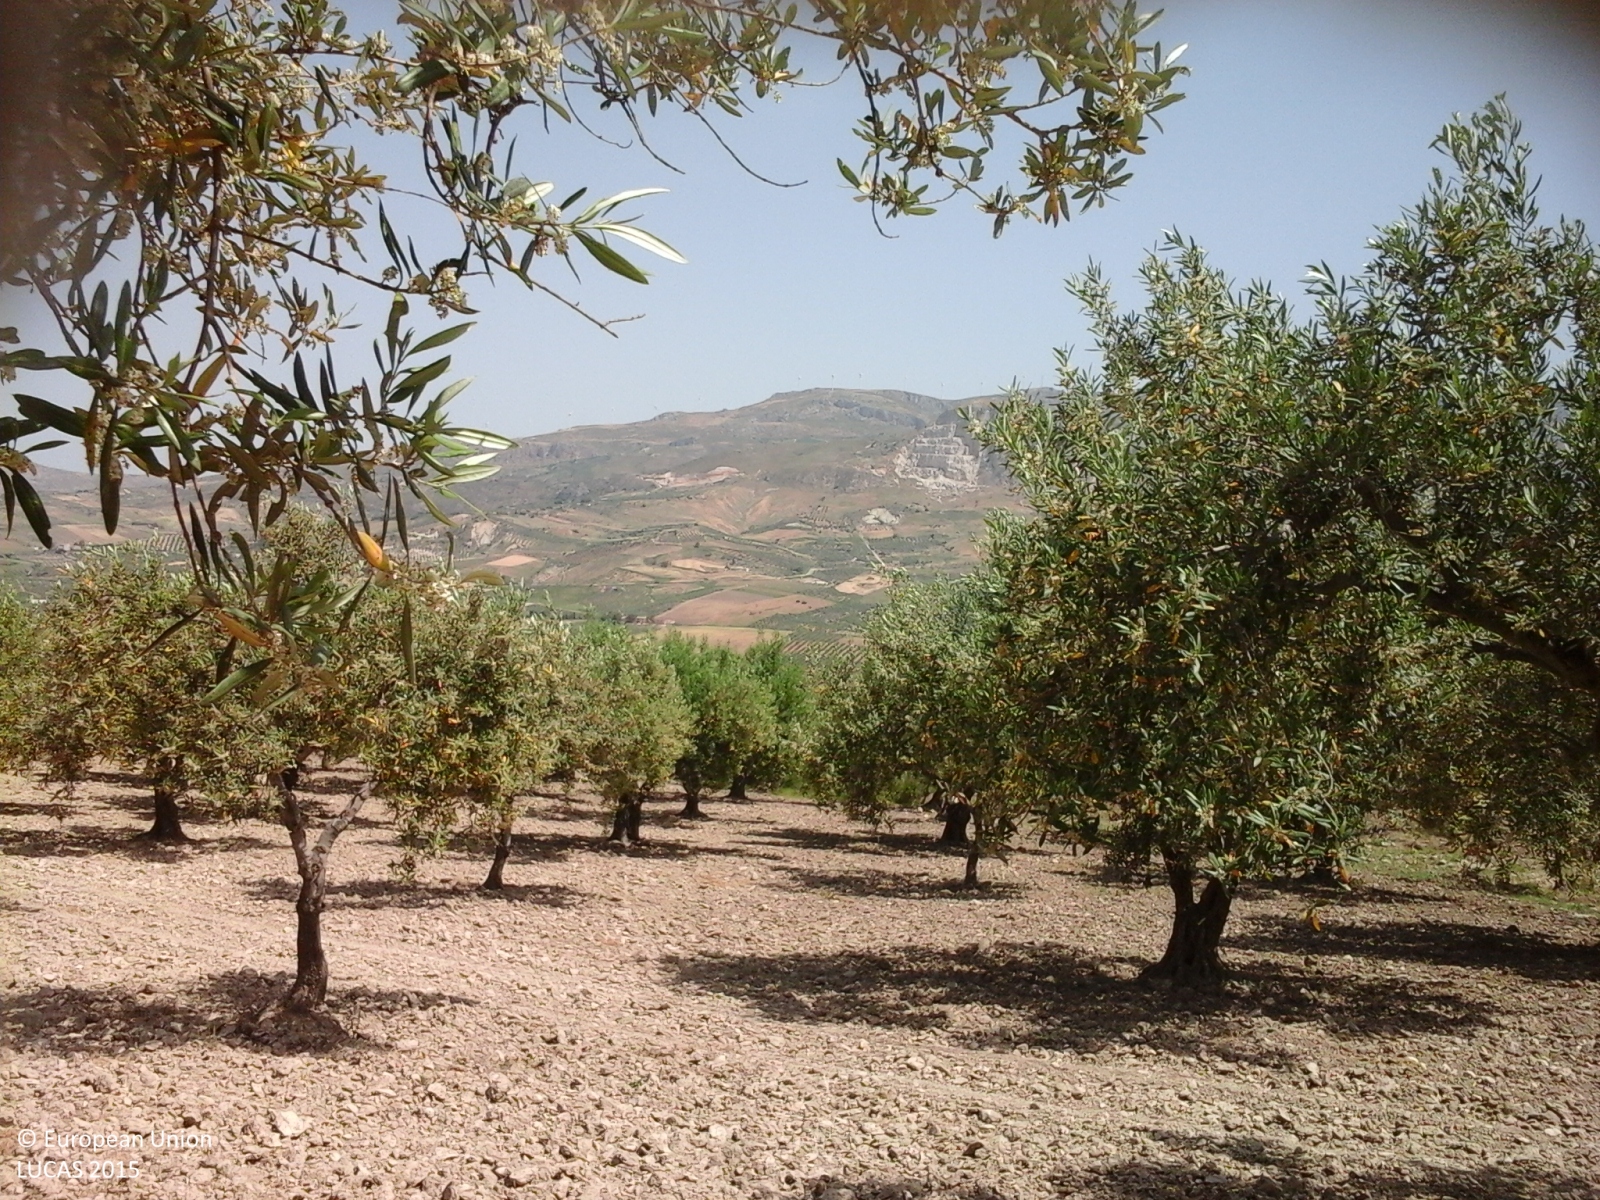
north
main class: Cropland
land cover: Olive groves
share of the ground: 50 - 75 %
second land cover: Other bare soil
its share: > 75 %
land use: Agriculture (excluding fallow land and kitchen gardens)
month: May
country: IT
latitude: 37.5332
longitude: 13.1109
